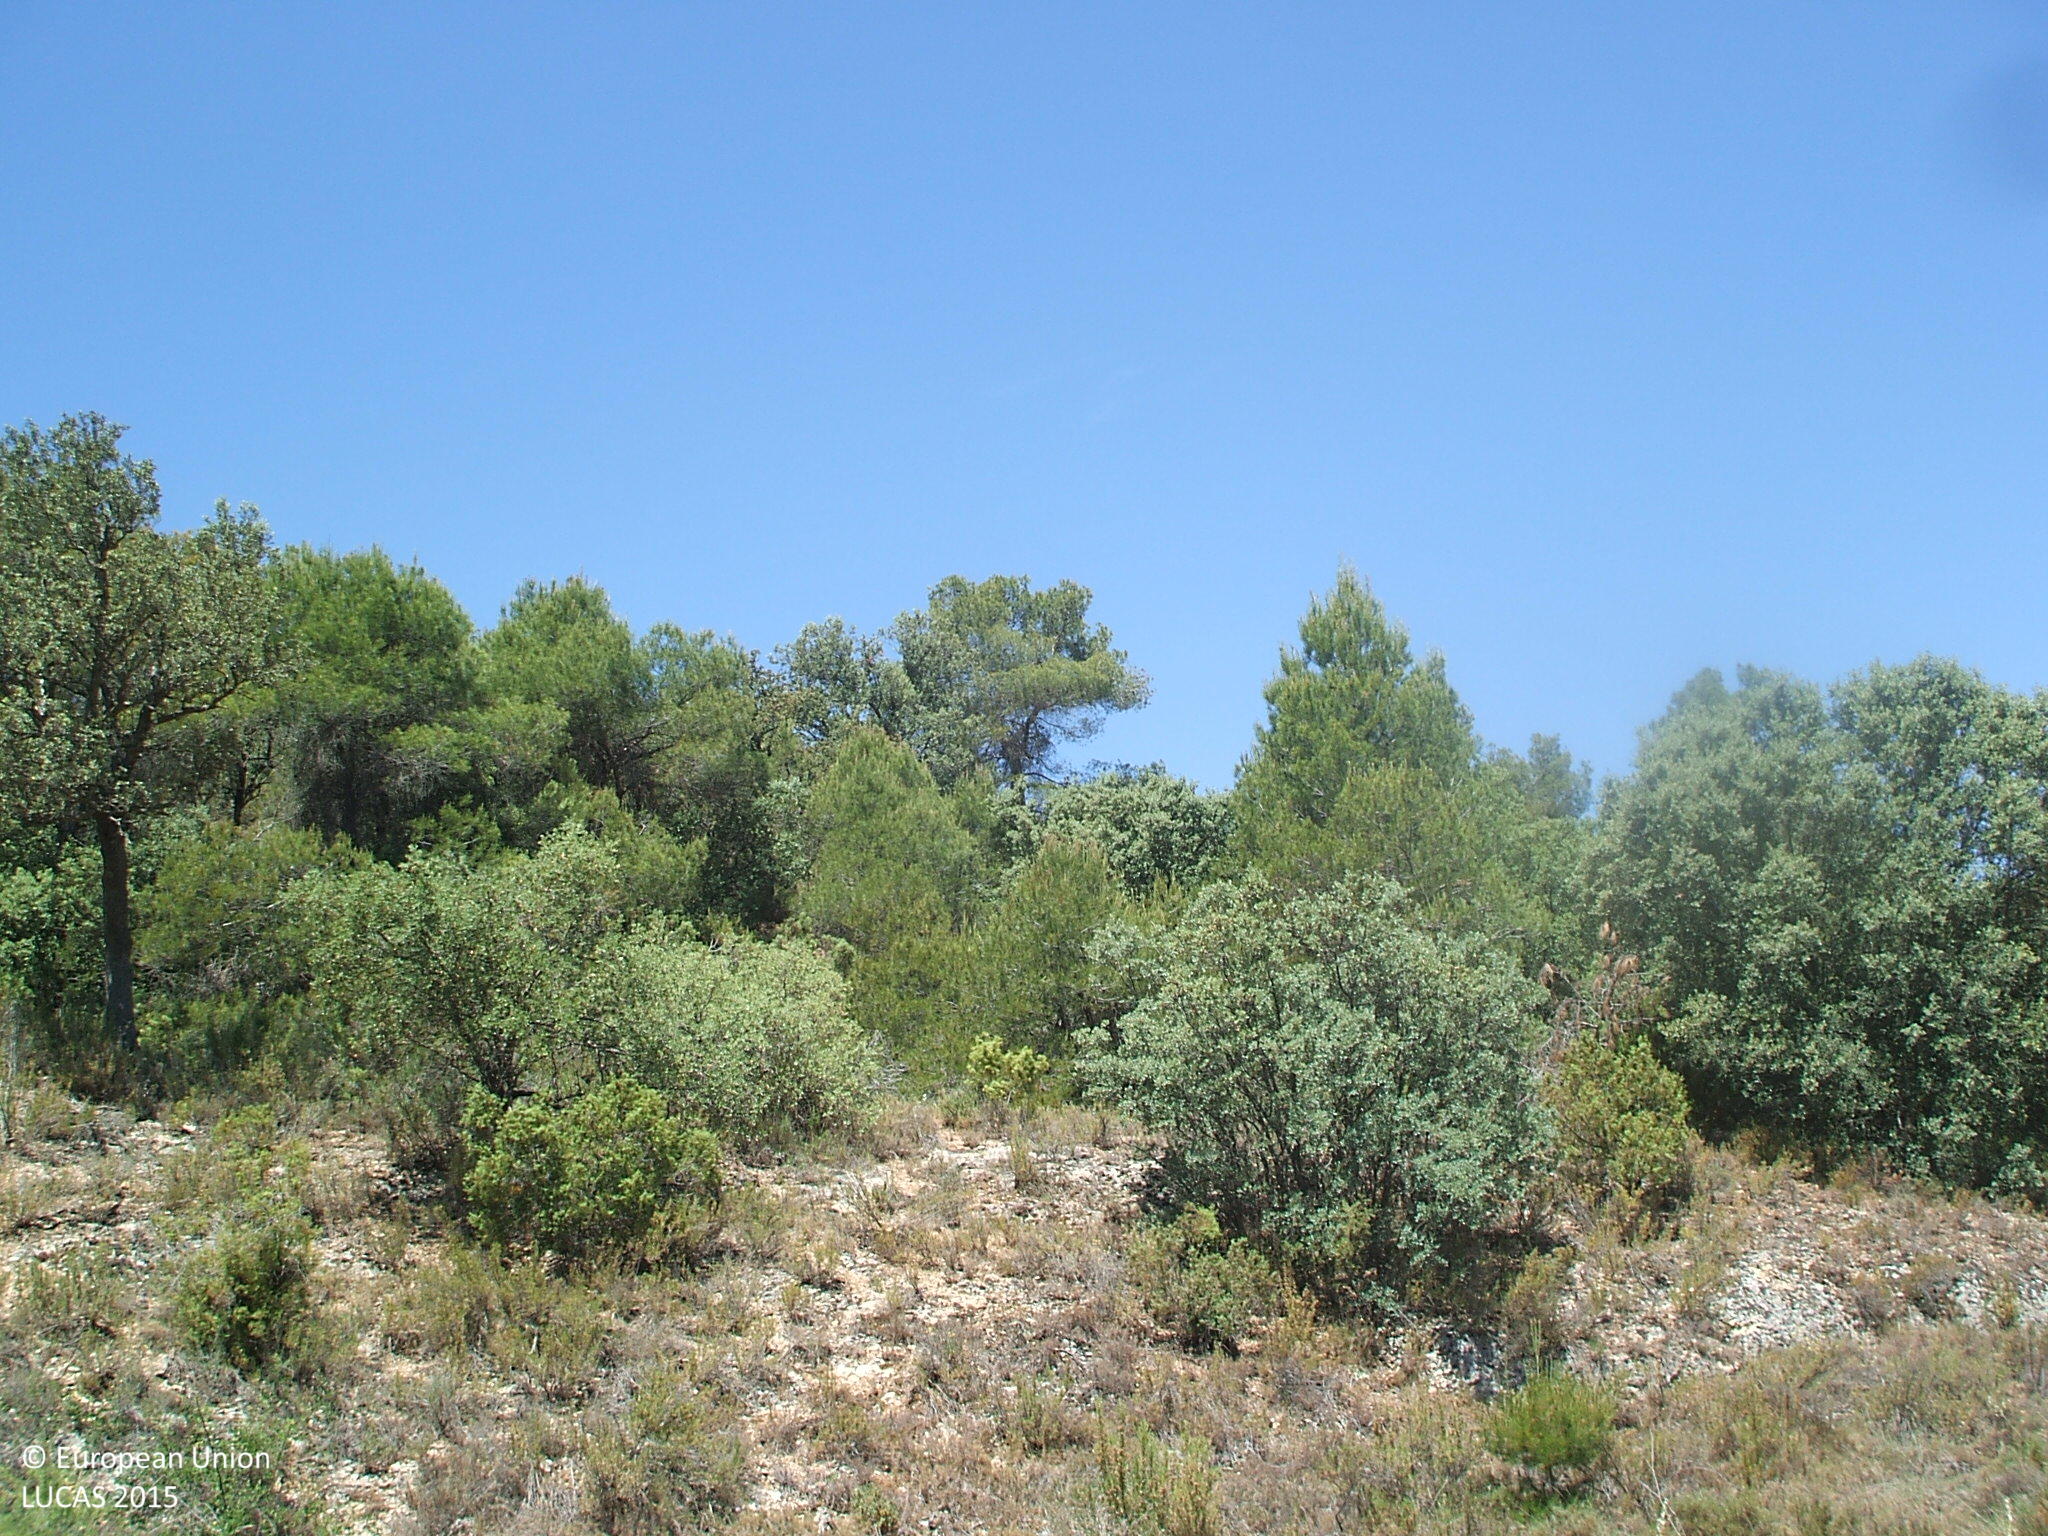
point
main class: Woodland
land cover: Pine dominated mixed woodland
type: coniferous forest of the mediterranean region
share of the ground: 50 - 75 %
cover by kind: shrubs 50 %, coniferous forest trees 25 %, broadleaved forest trees 25 %
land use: Semi-natural and natural areas not in use
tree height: > 5 m
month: June
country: ES
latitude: 40.8471
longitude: -0.0078
